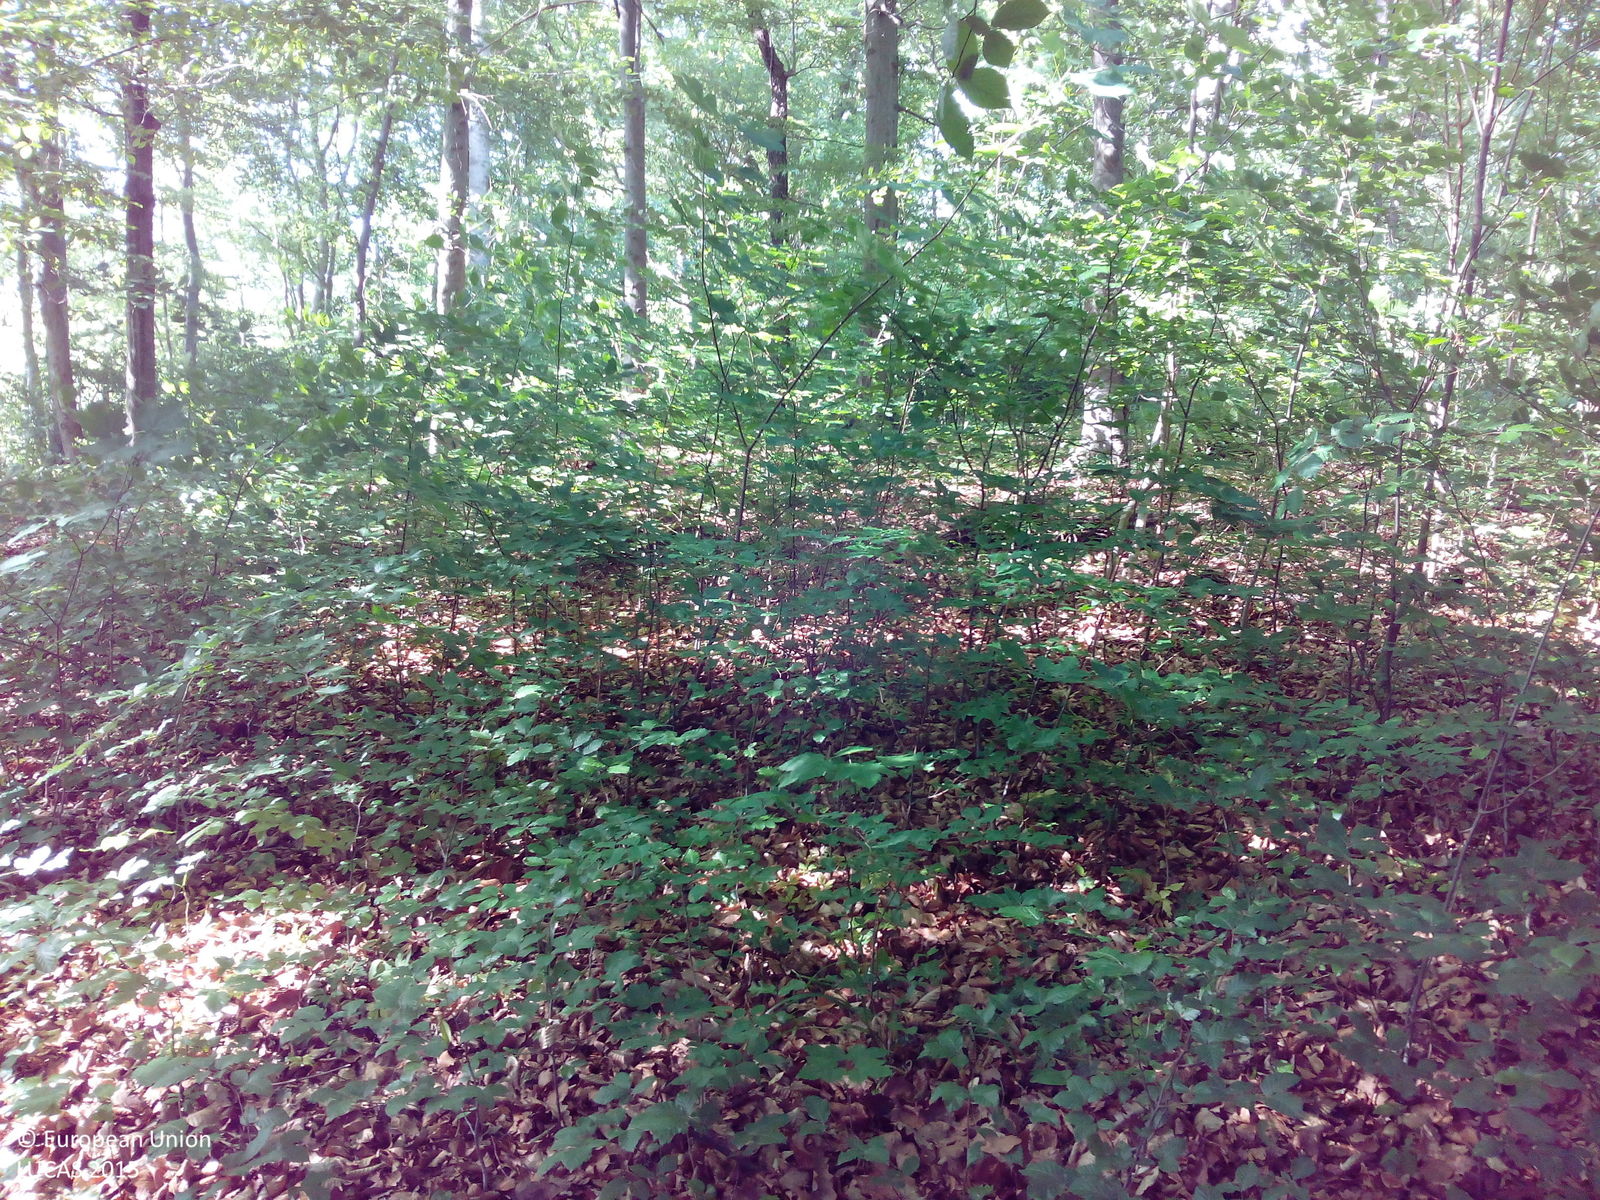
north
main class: Woodland
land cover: Broadleaved woodland
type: beech forest
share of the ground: > 75 %
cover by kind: broadleaved forest trees 85 %, unconsolidated bare surface 10 %, shrubs 5 %
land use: Forestry
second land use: Amenities, museums, leisure
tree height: > 5 m
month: June
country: DE
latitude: 50.7863
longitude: 11.4606
